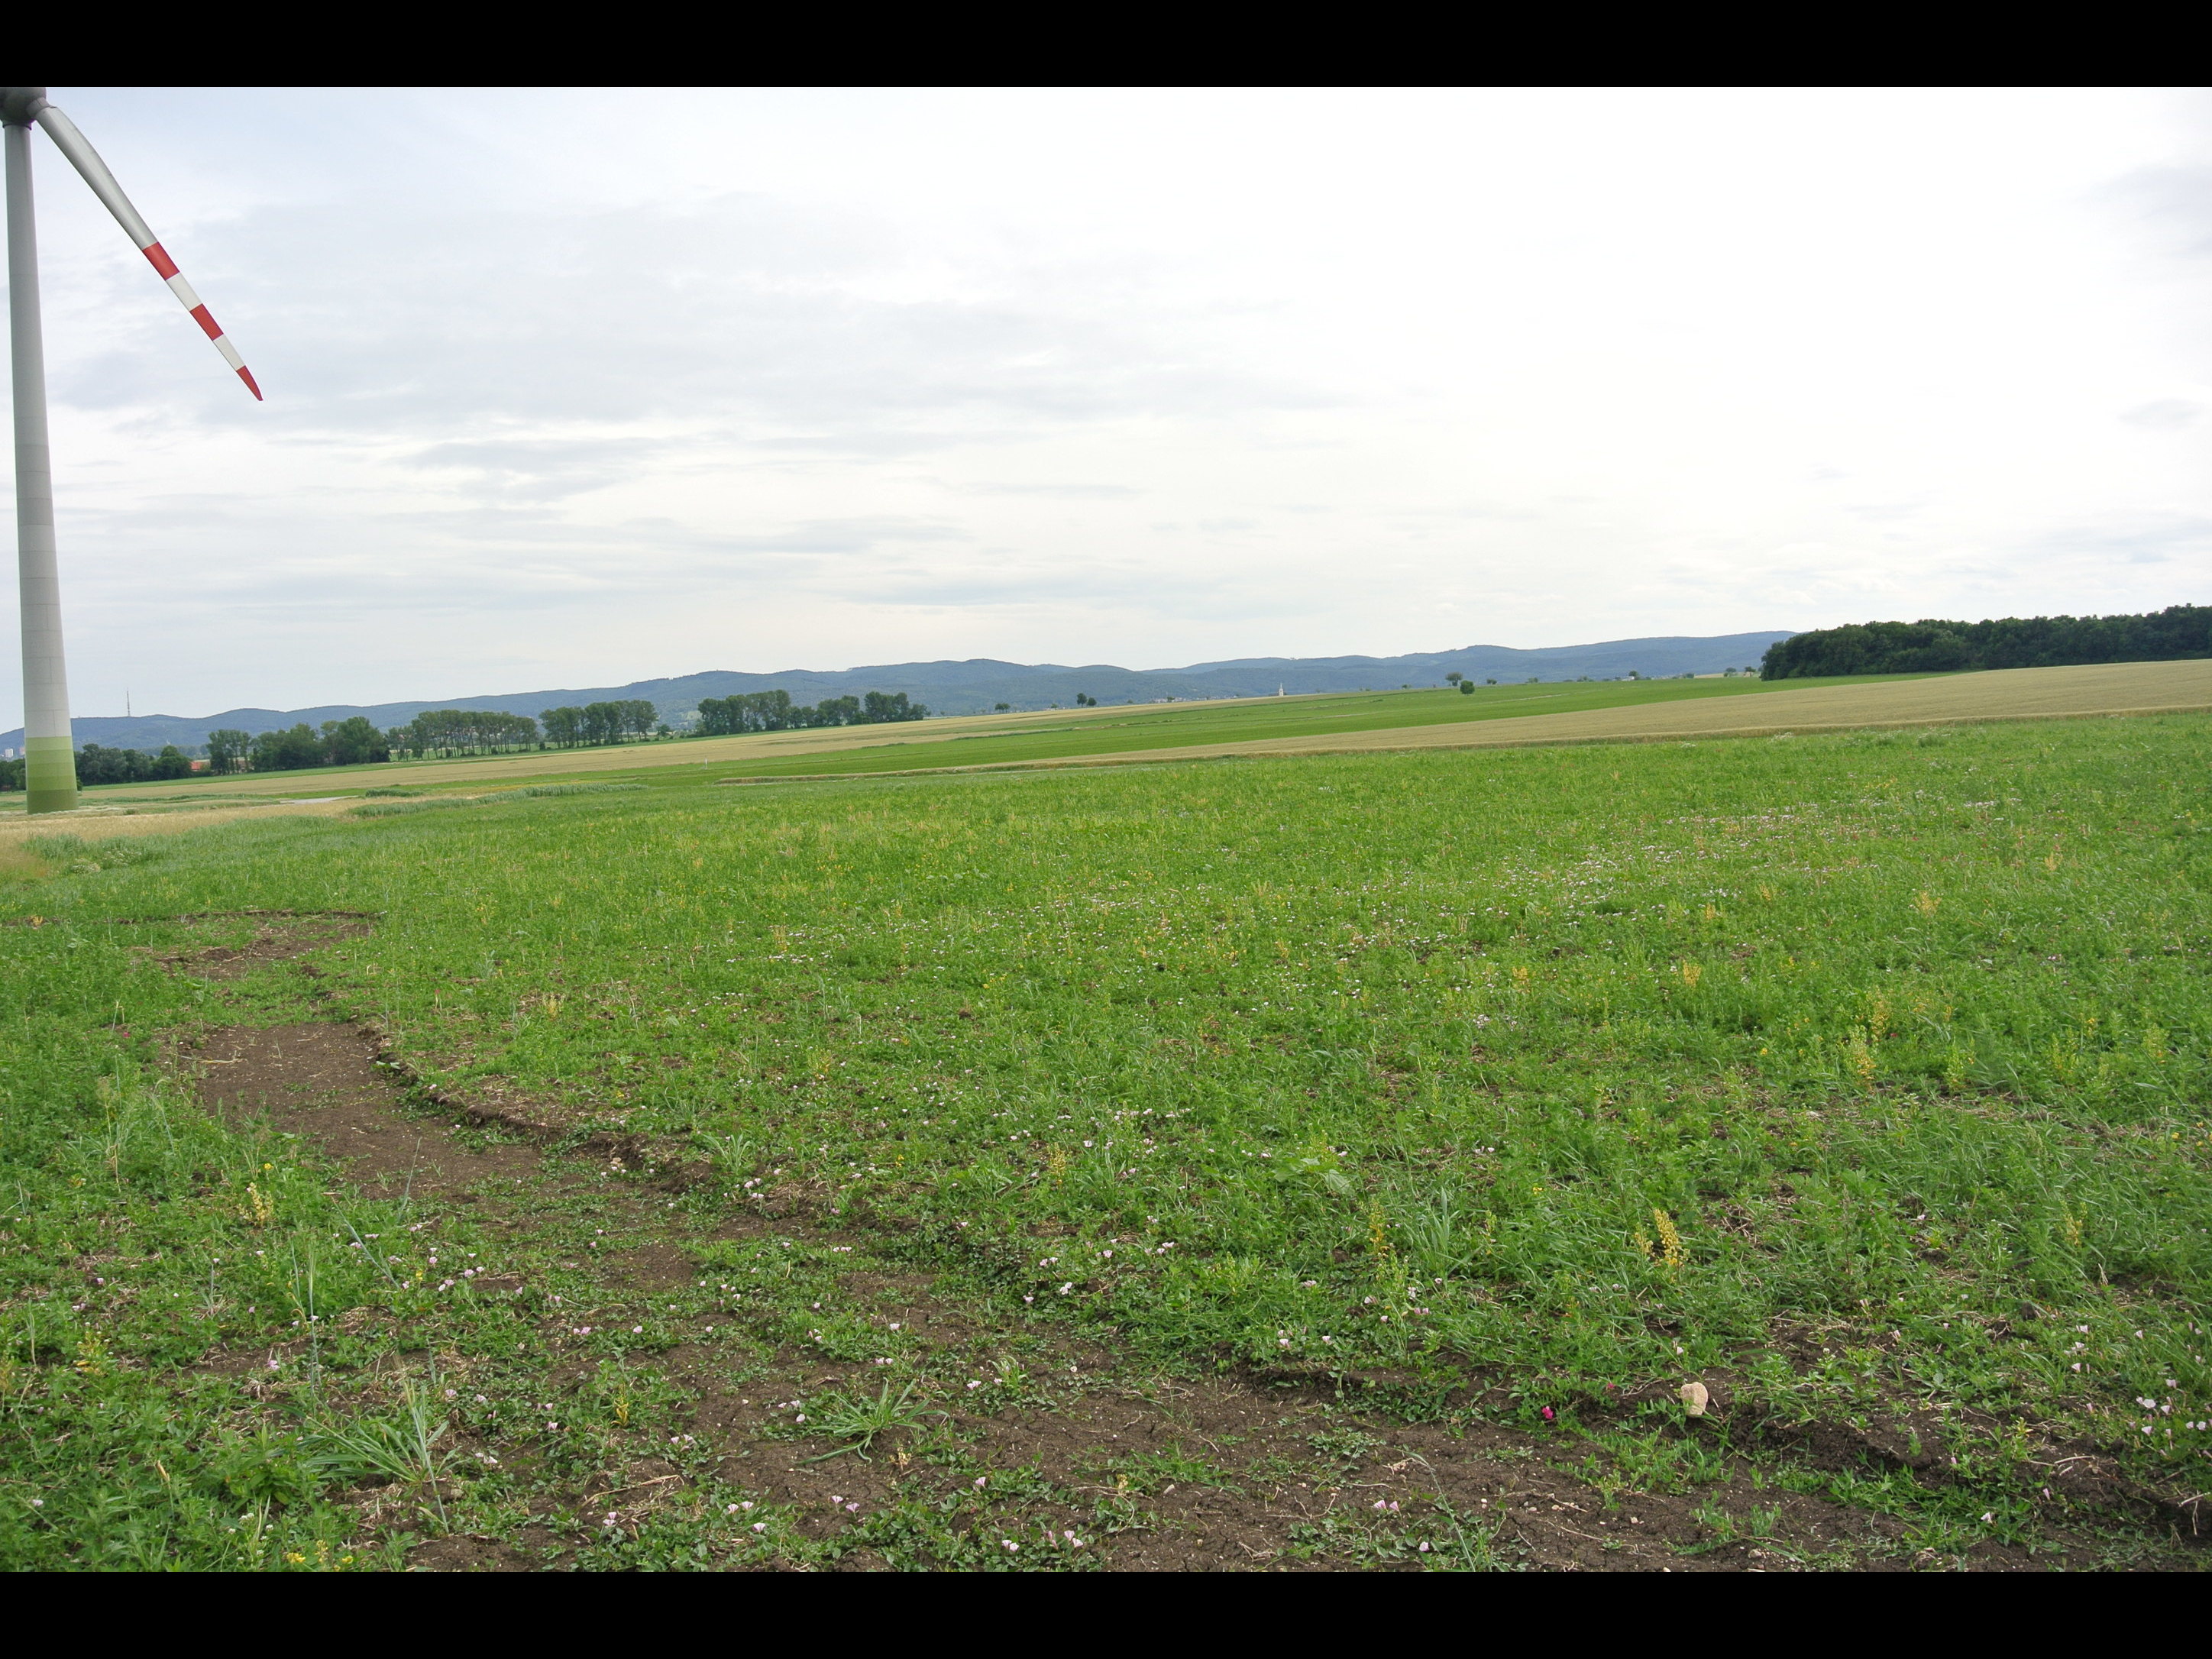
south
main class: Cropland
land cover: Other leguminous and mixtures for fodder
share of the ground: > 75 %
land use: Agriculture (excluding fallow land and kitchen gardens)
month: June
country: AT
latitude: 47.7413
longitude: 16.5259
